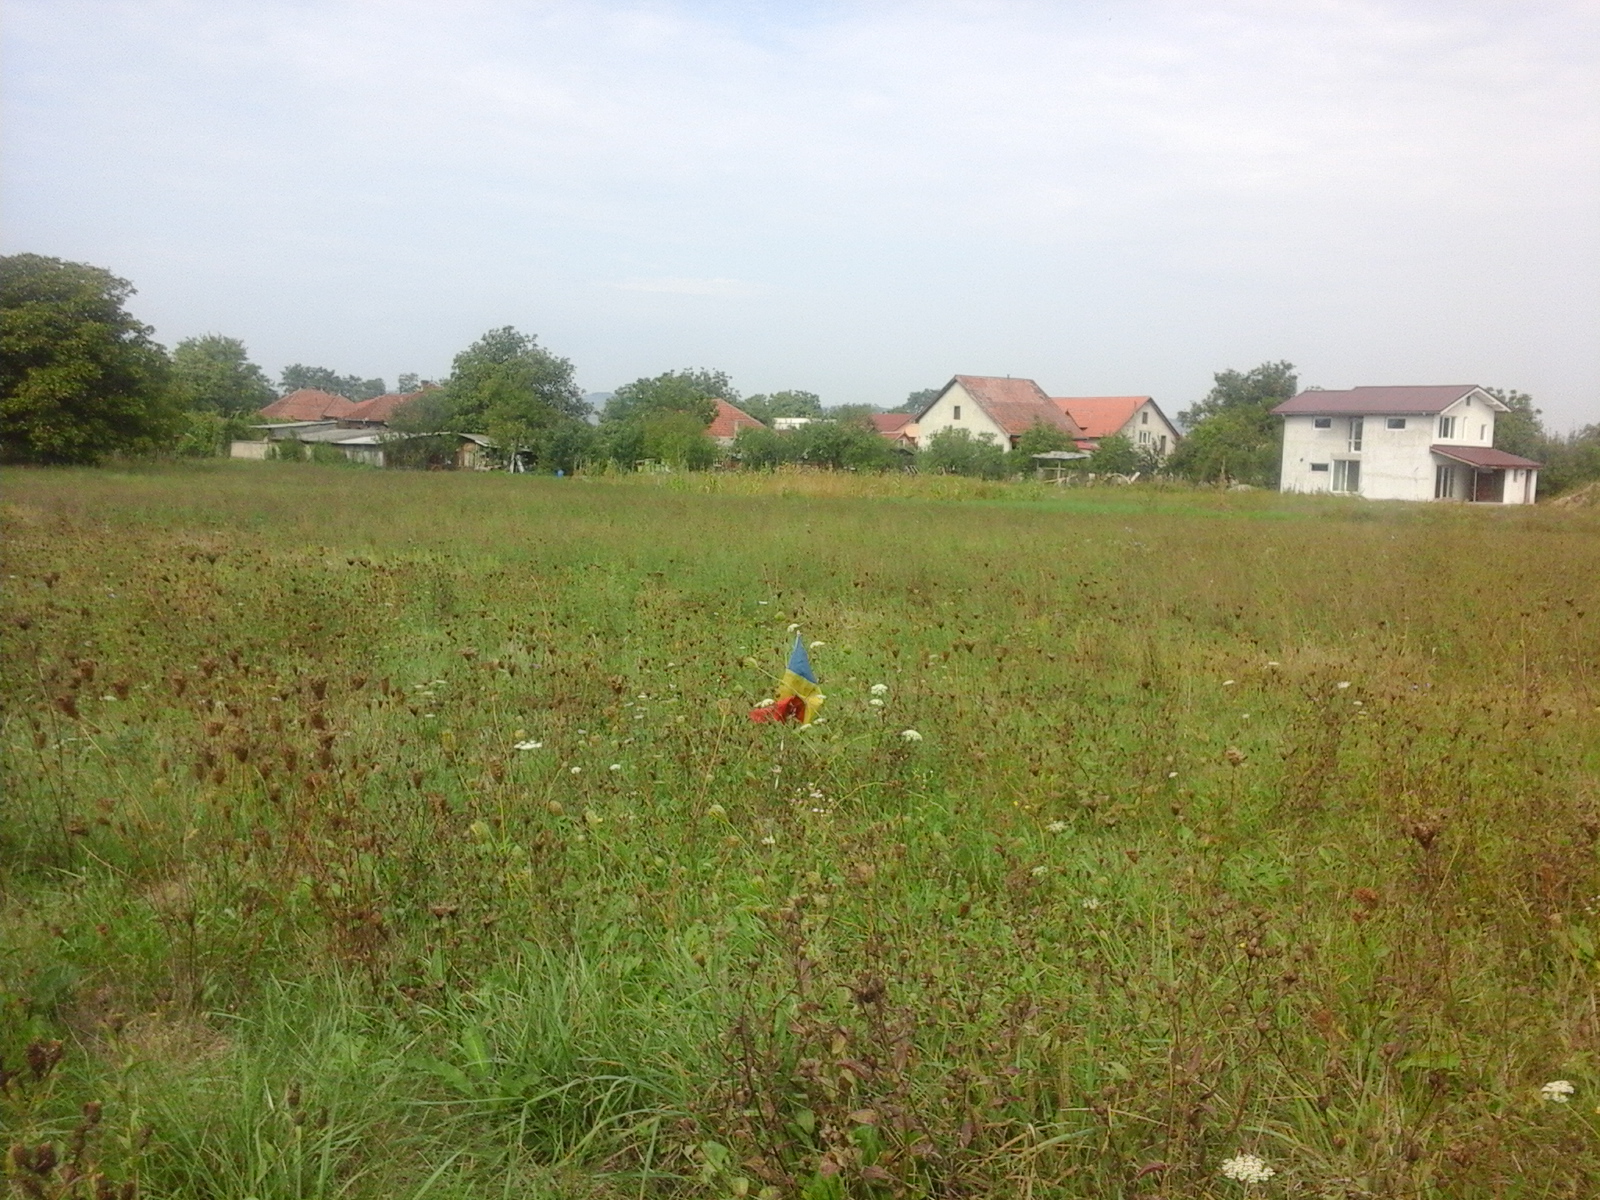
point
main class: Grassland
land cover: Spontaneously vegetated surfaces
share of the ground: > 75 %
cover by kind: herbaceous plants 100 %
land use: Agriculture (excluding fallow land and kitchen gardens)
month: September
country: RO
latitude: 45.7159
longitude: 23.0170
